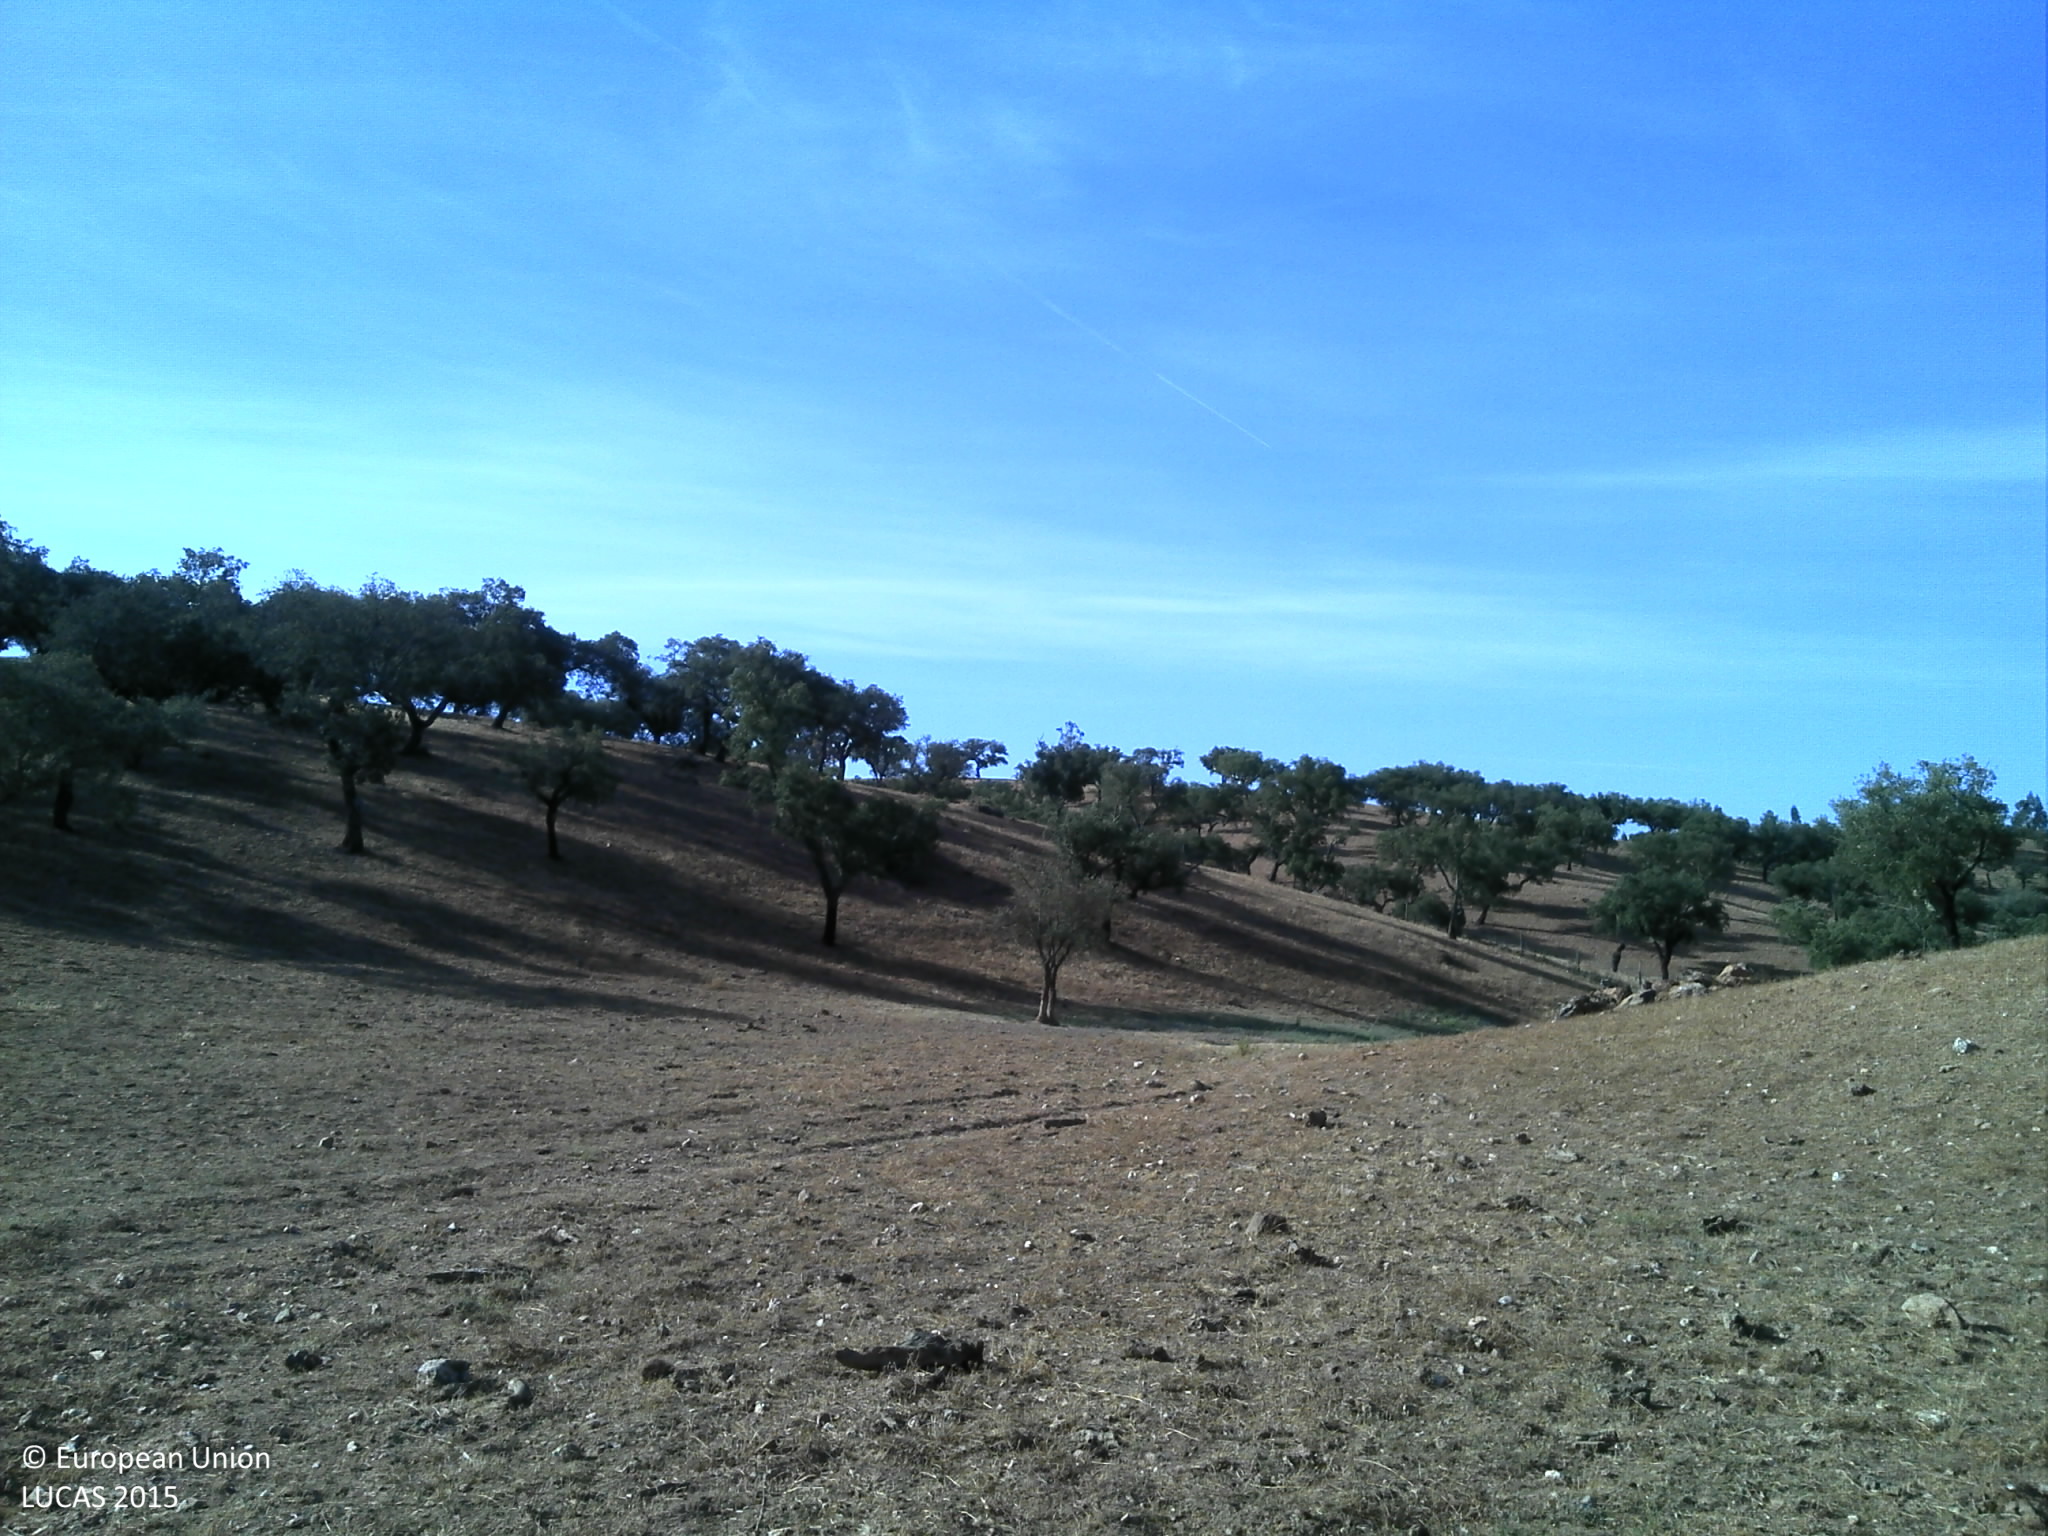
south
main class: Woodland
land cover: Broadleaved woodland
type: broadleaved evergreen forest
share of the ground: 10 - 25 %
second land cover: Grassland without tree/shrub cover
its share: 10 - 25 %
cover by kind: unconsolidated bare surface 80 %, broadleaved forest trees 10 %, herbaceous plants 10 %
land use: Forestry
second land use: Agriculture (excluding fallow land and kitchen gardens)
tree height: > 5 m
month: July
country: PT
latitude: 38.3236
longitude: -7.6321
